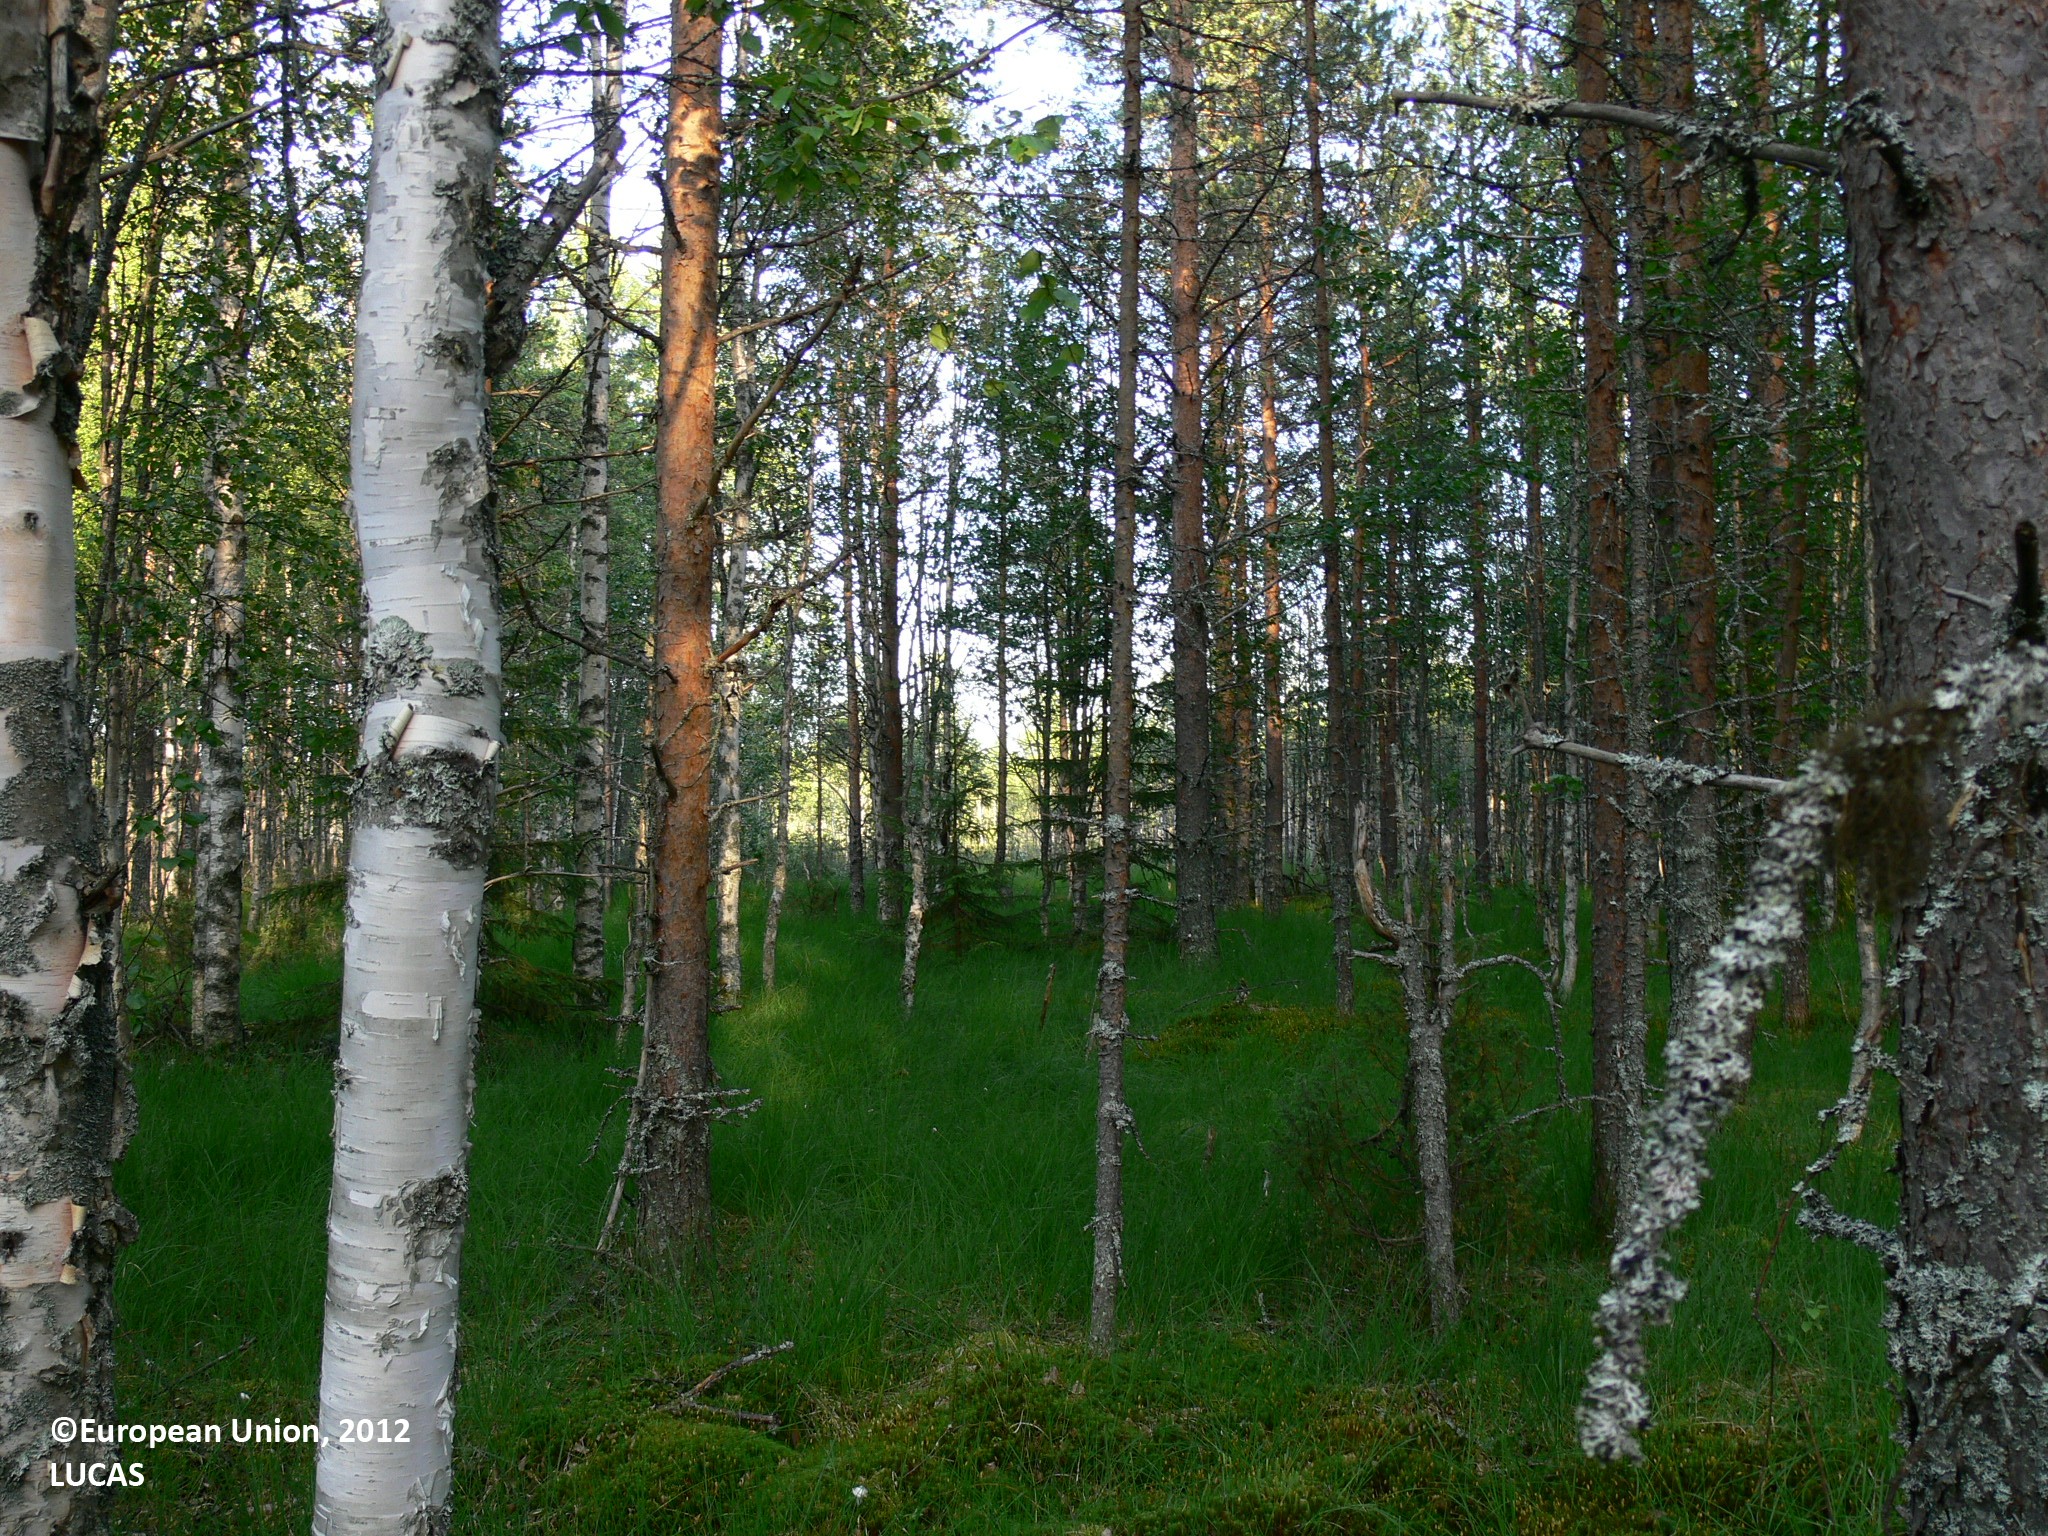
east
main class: Woodland
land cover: Pine dominated mixed woodland
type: boreal forest
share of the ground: > 75 %
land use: Forestry
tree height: > 5 m
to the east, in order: Pine dominated mixed woodland; Ditches and canals; Pine dominated mixed woodland; Broadleaved woodland; Peatbogs; Pine dominated coniferous woodland
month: July
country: FI
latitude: 63.3262
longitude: 30.8331
